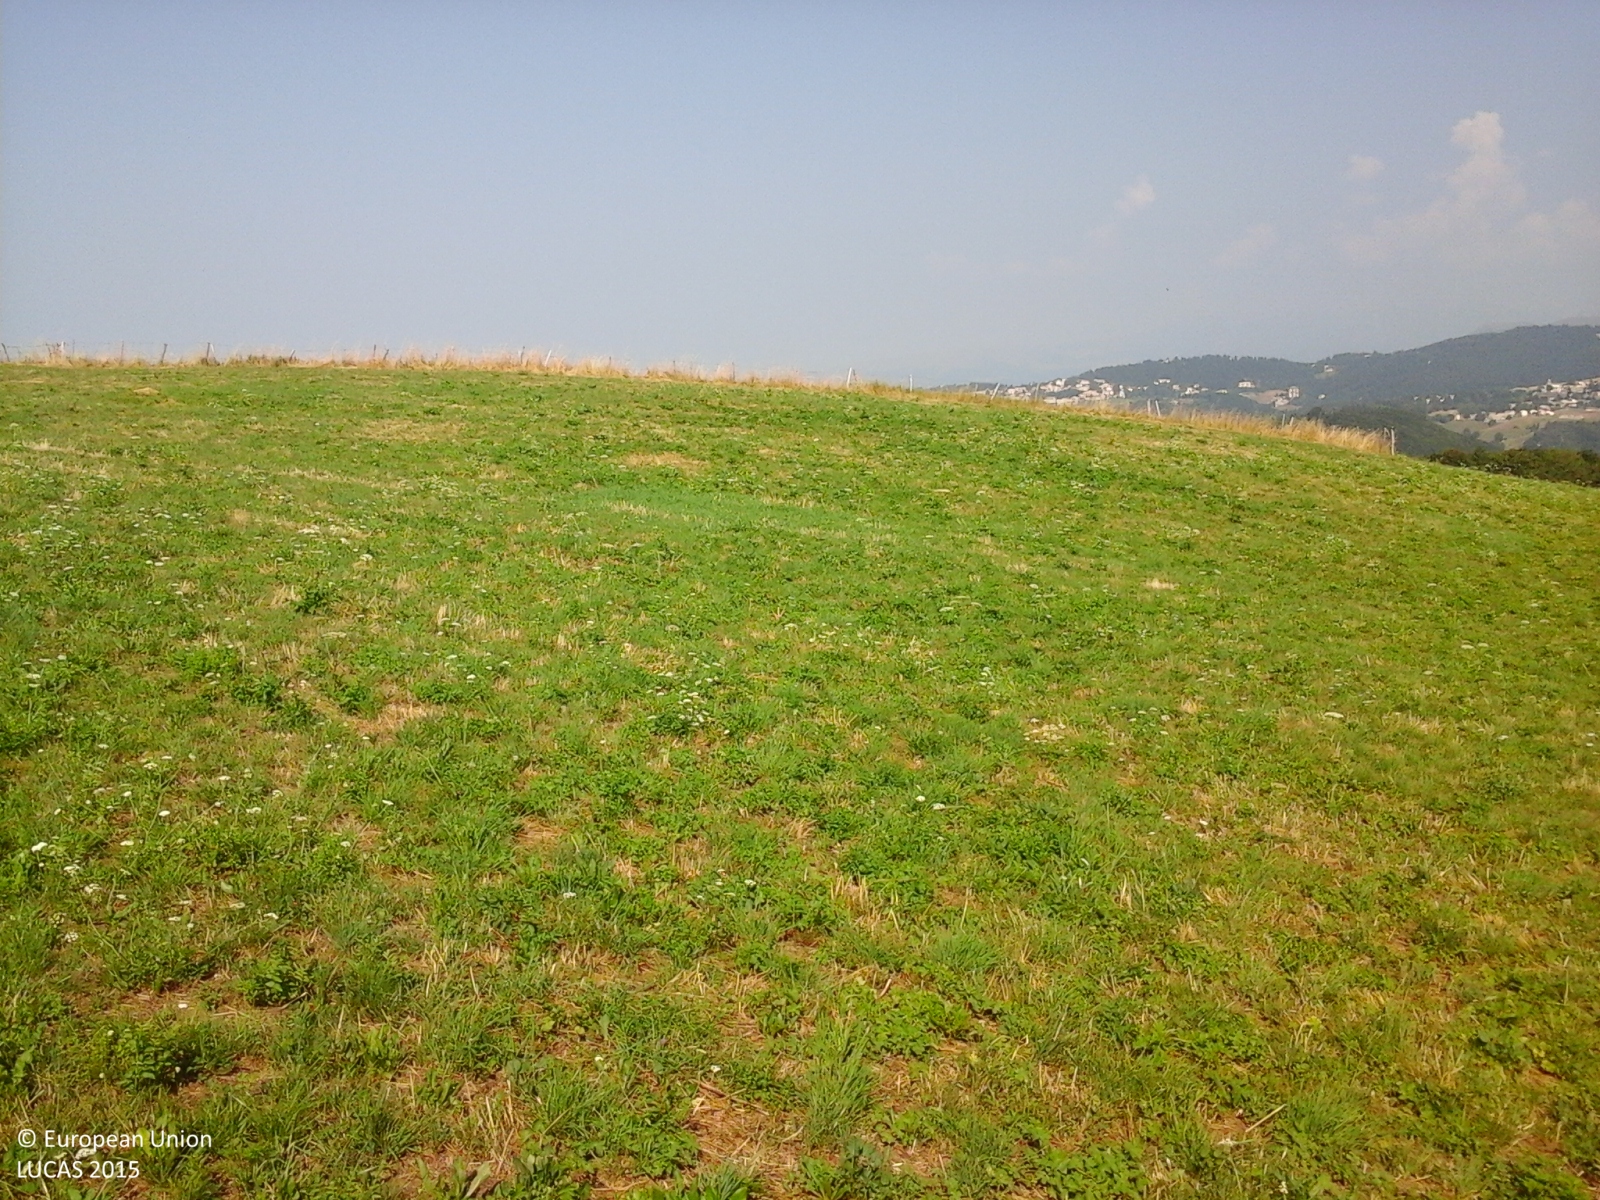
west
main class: Grassland
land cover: Grassland without tree/shrub cover
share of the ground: > 75 %
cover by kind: herbaceous plants 100 %
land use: Agriculture (excluding fallow land and kitchen gardens)
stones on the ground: < 10 %
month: July
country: IT
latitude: 45.6069
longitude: 11.0881
